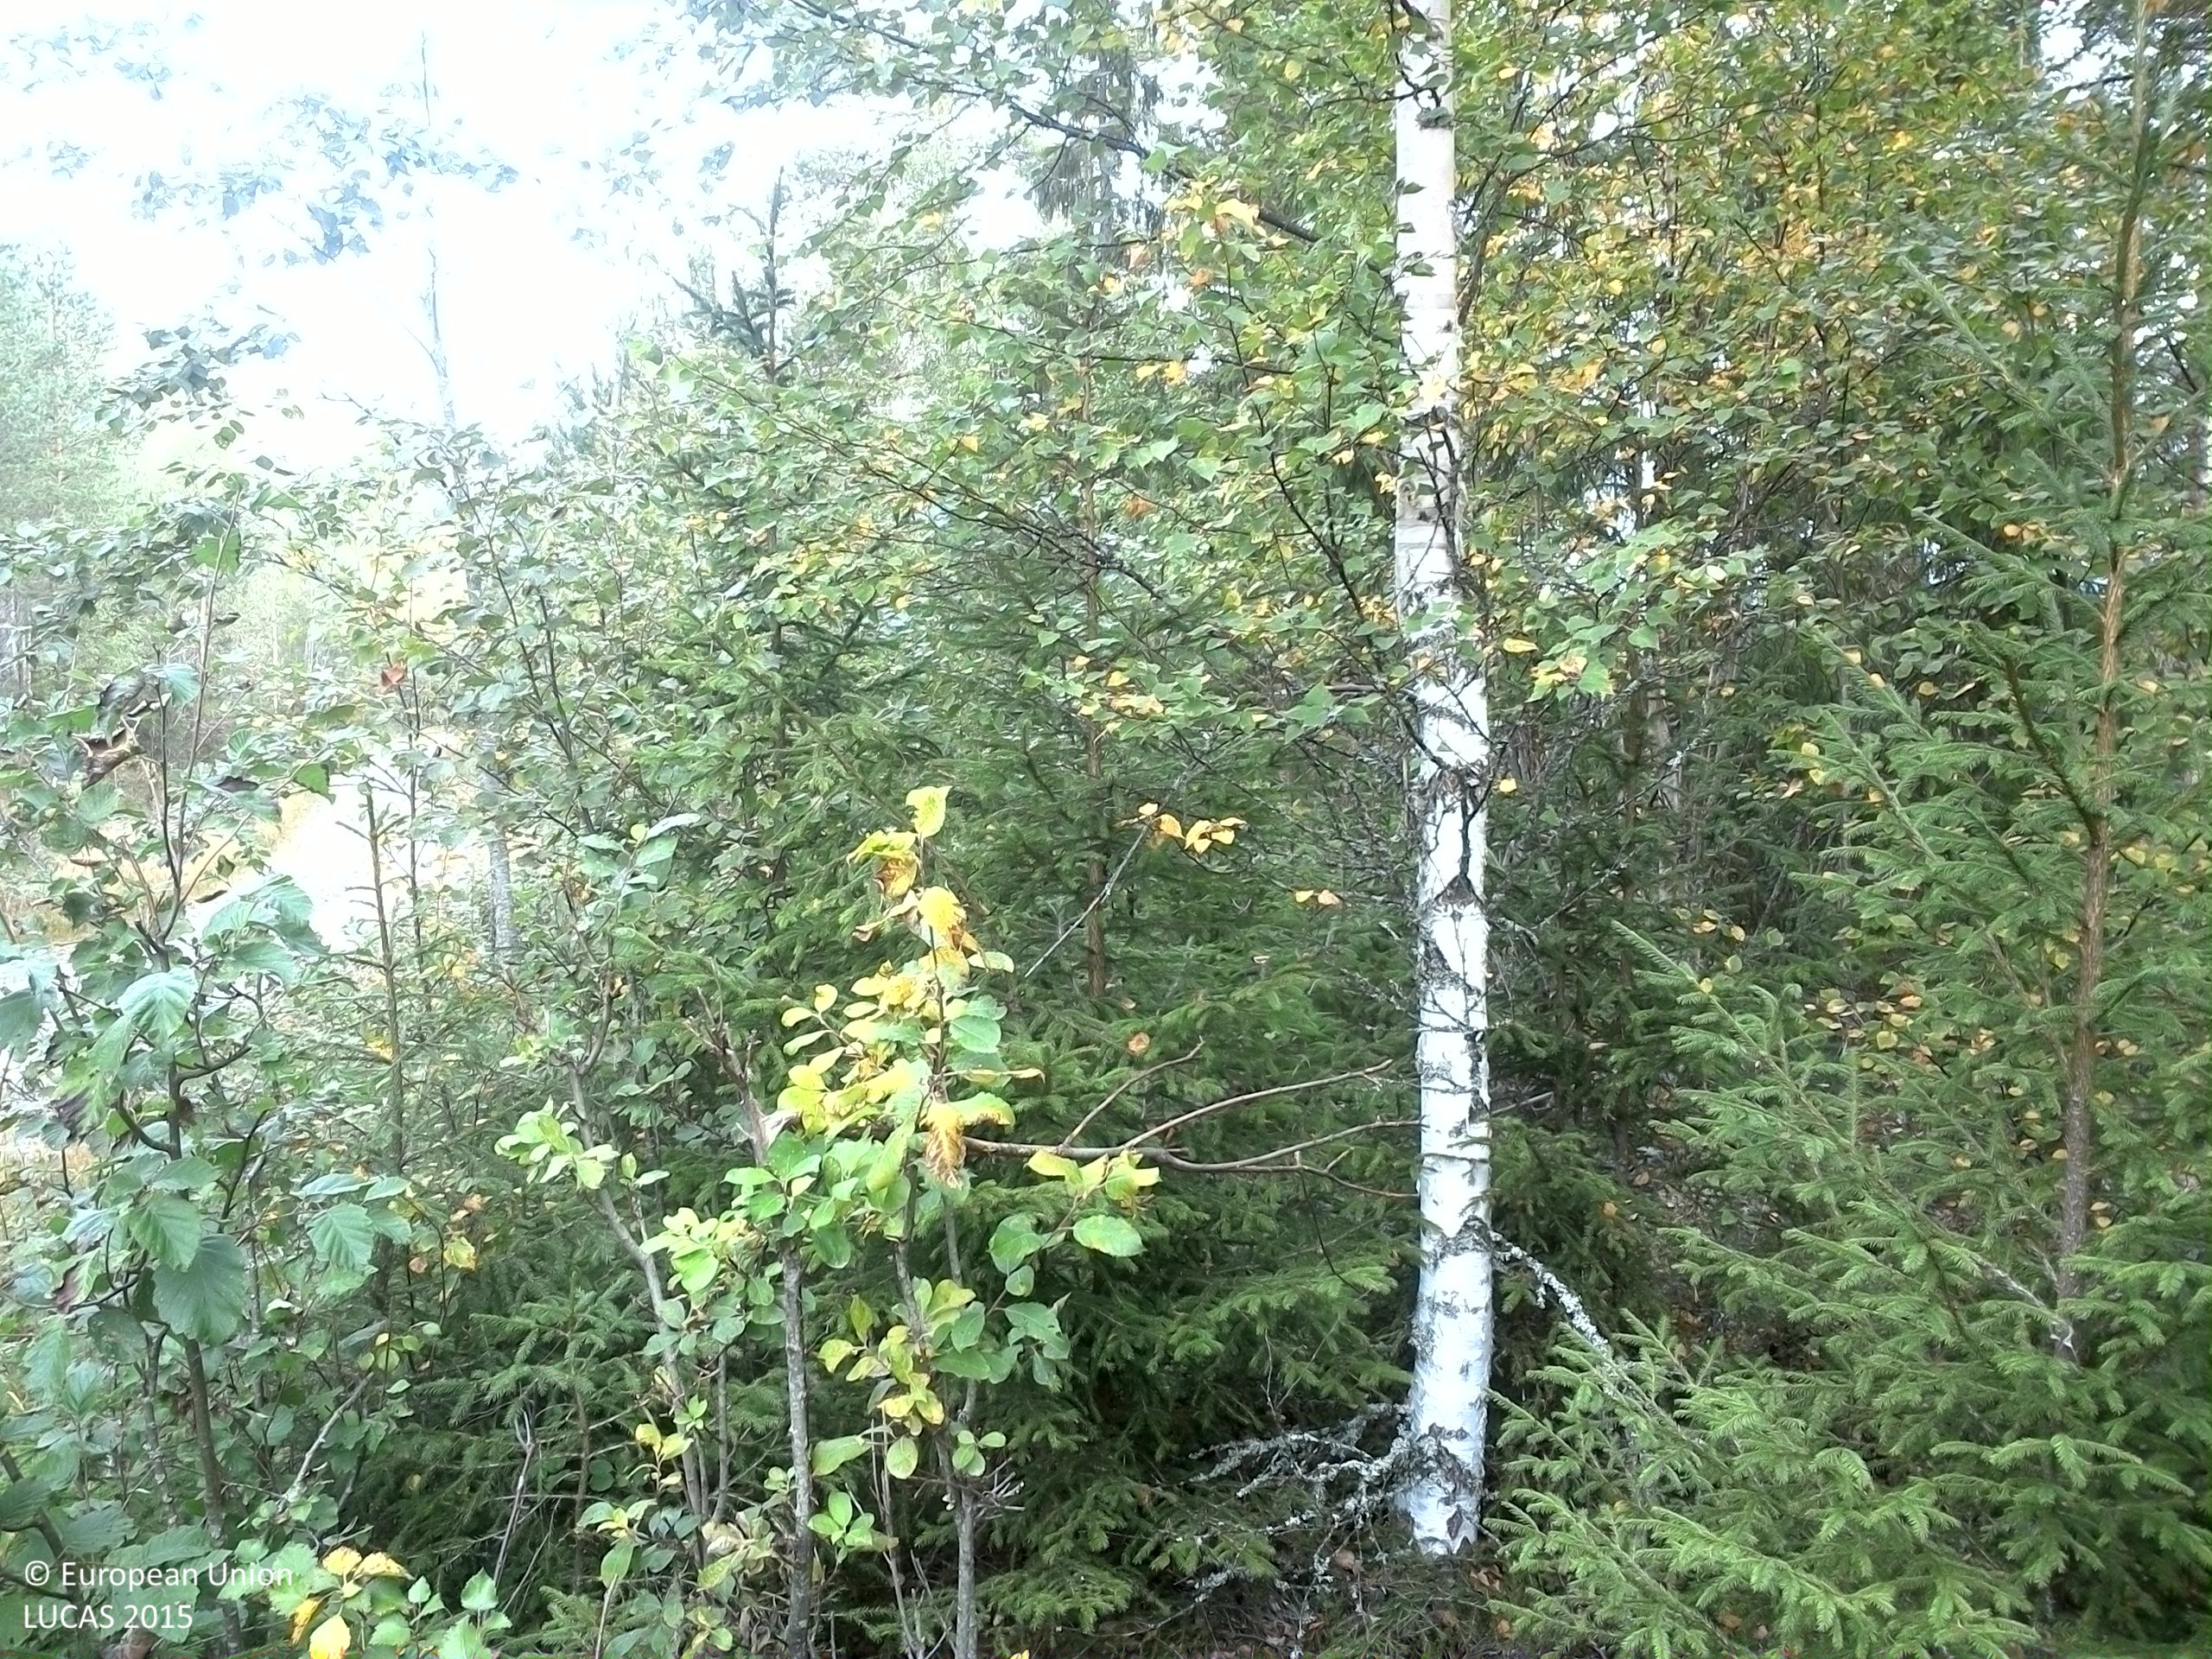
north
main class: Woodland
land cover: Other mixed woodland
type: boreal forest
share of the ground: 25 - 50 %
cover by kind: shrubs 30 %, coniferous forest trees 20 %, broadleaved forest trees 20 %, lichens and mosses 15 %, herbaceous plants 10 %, consolidated bare surface 5 %
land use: Forestry
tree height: > 5 m
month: September
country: SE
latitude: 61.6316
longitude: 15.3605
